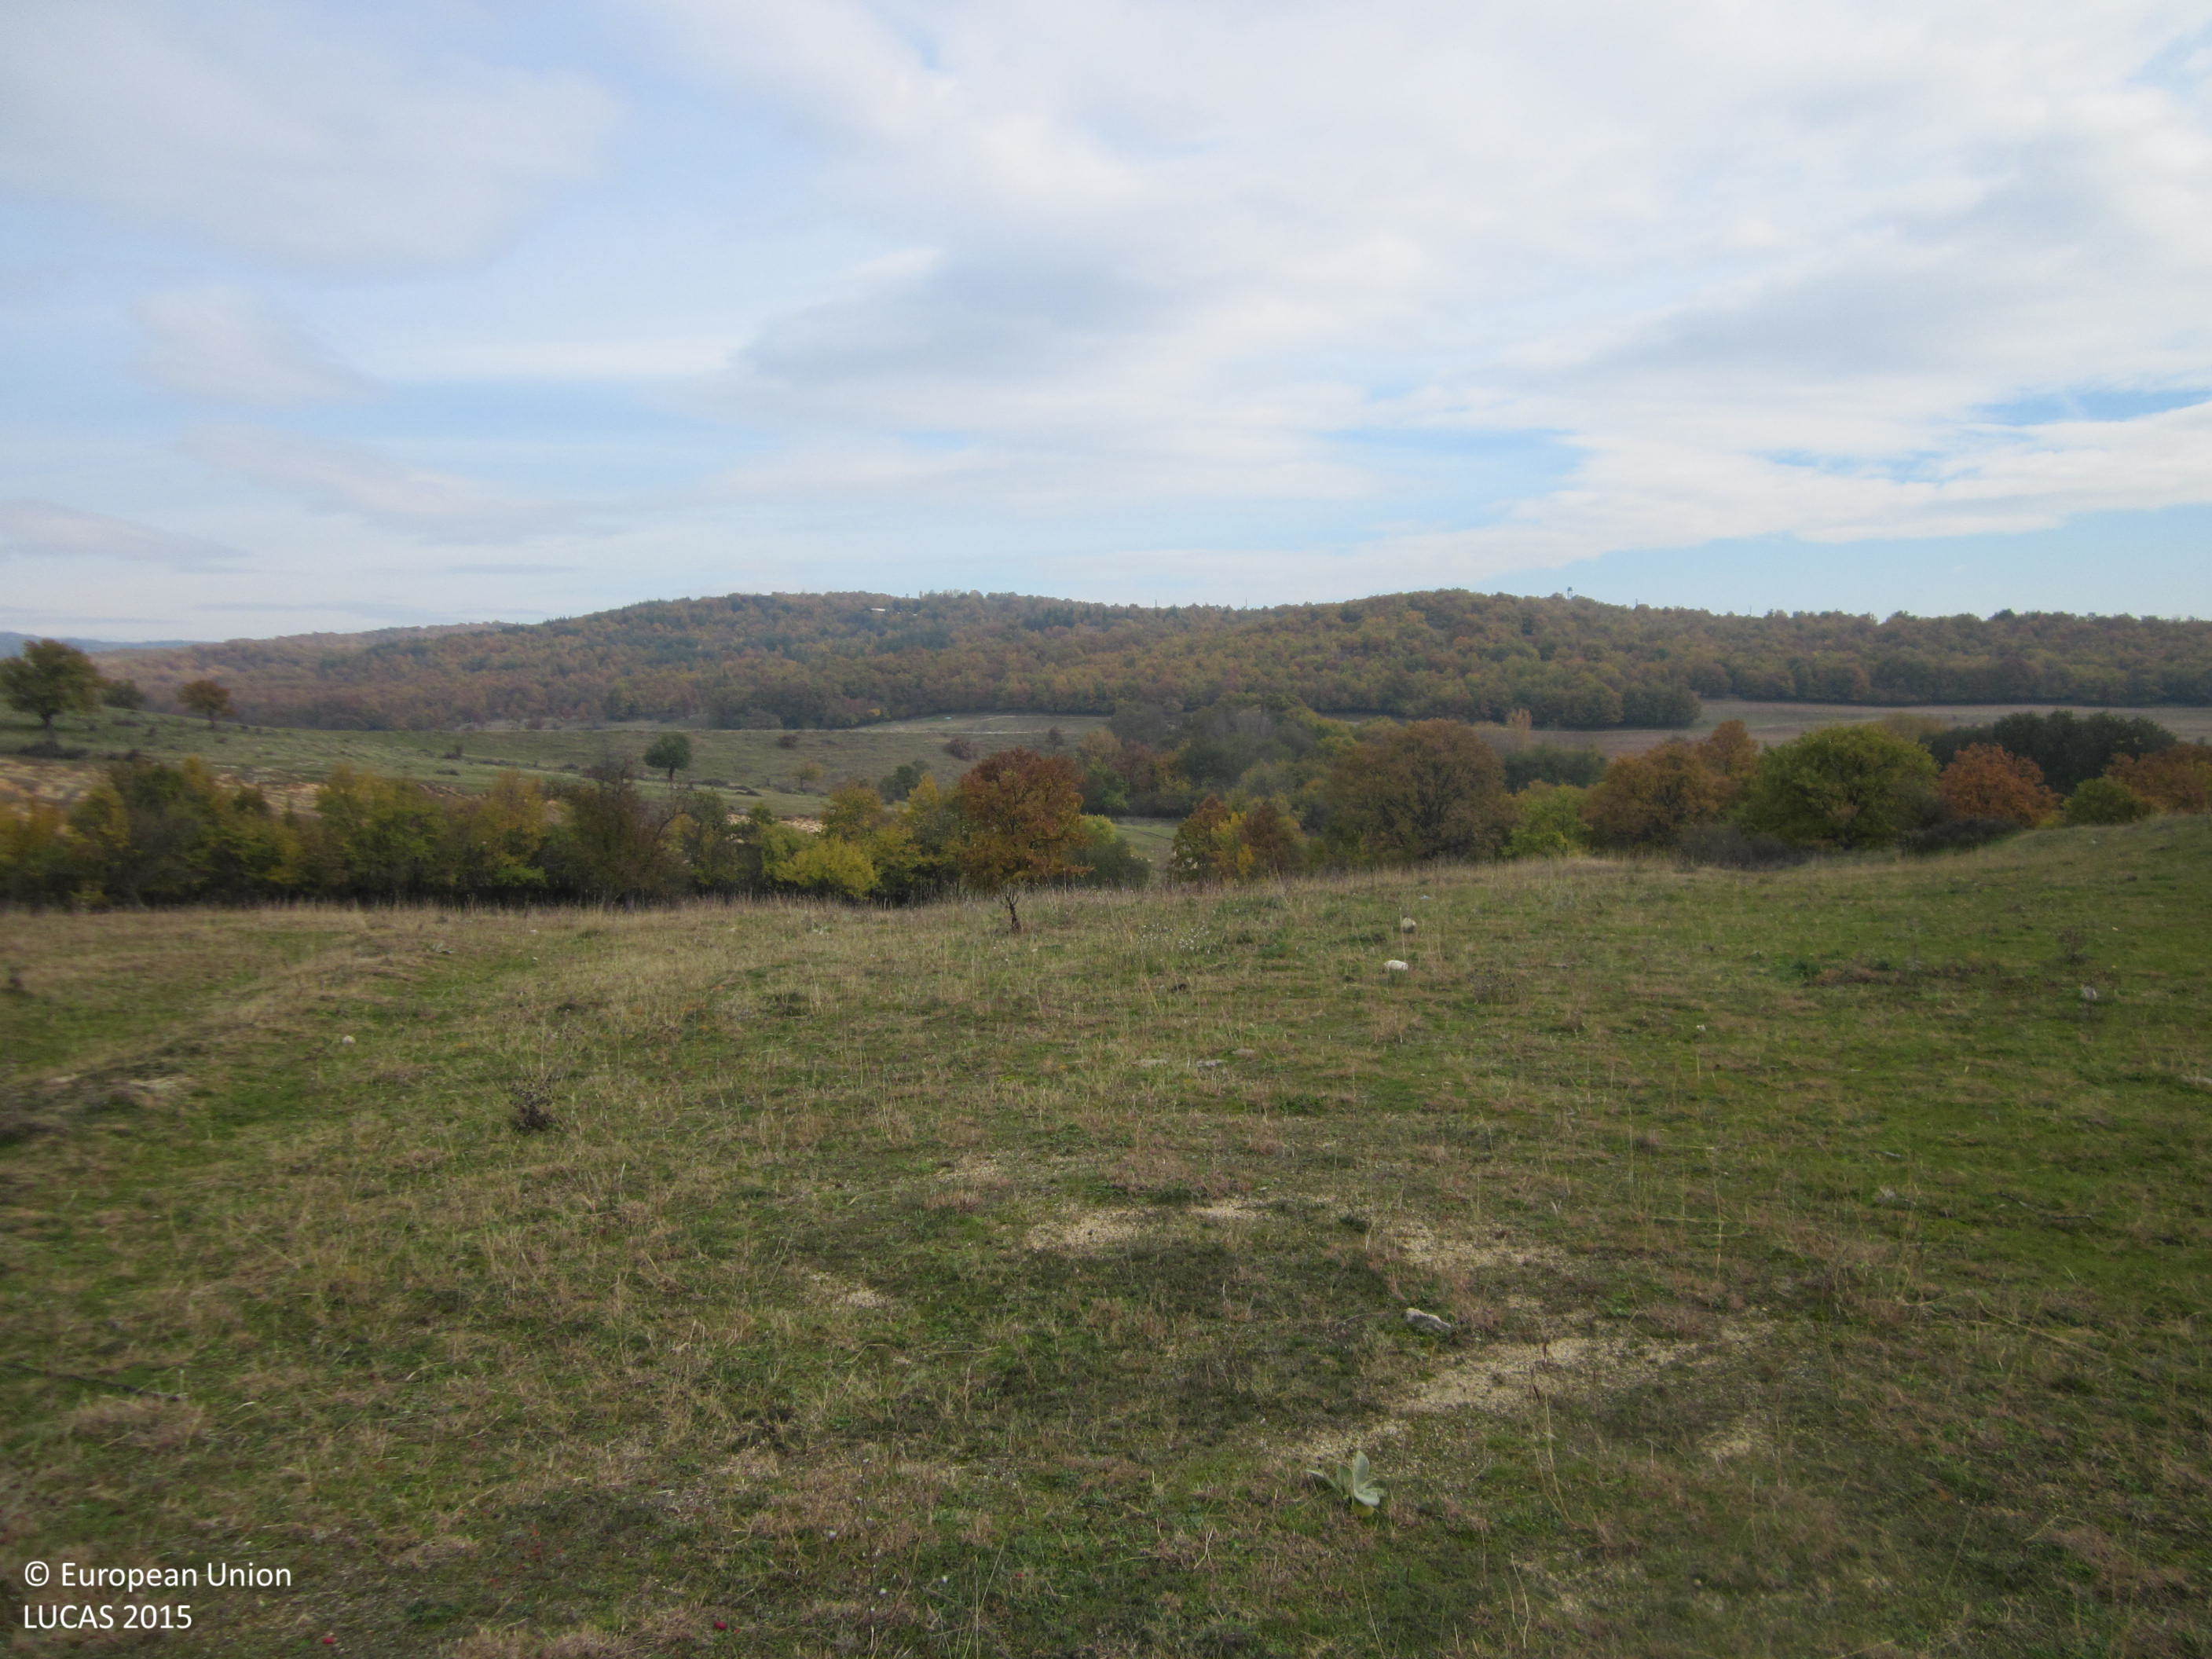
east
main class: Grassland
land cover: Grassland without tree/shrub cover
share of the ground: > 75 %
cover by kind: herbaceous plants 100 %
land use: Agriculture (excluding fallow land and kitchen gardens)
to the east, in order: Grassland without tree/shrub cover; Single bushes/trees; Grassland without tree/shrub cover; Abandoned hedges; Ditches and canals; Grassland with sparse tree/shrub cover; Broadleaved woodland
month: November
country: BG
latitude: 42.5700
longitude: 24.9093
